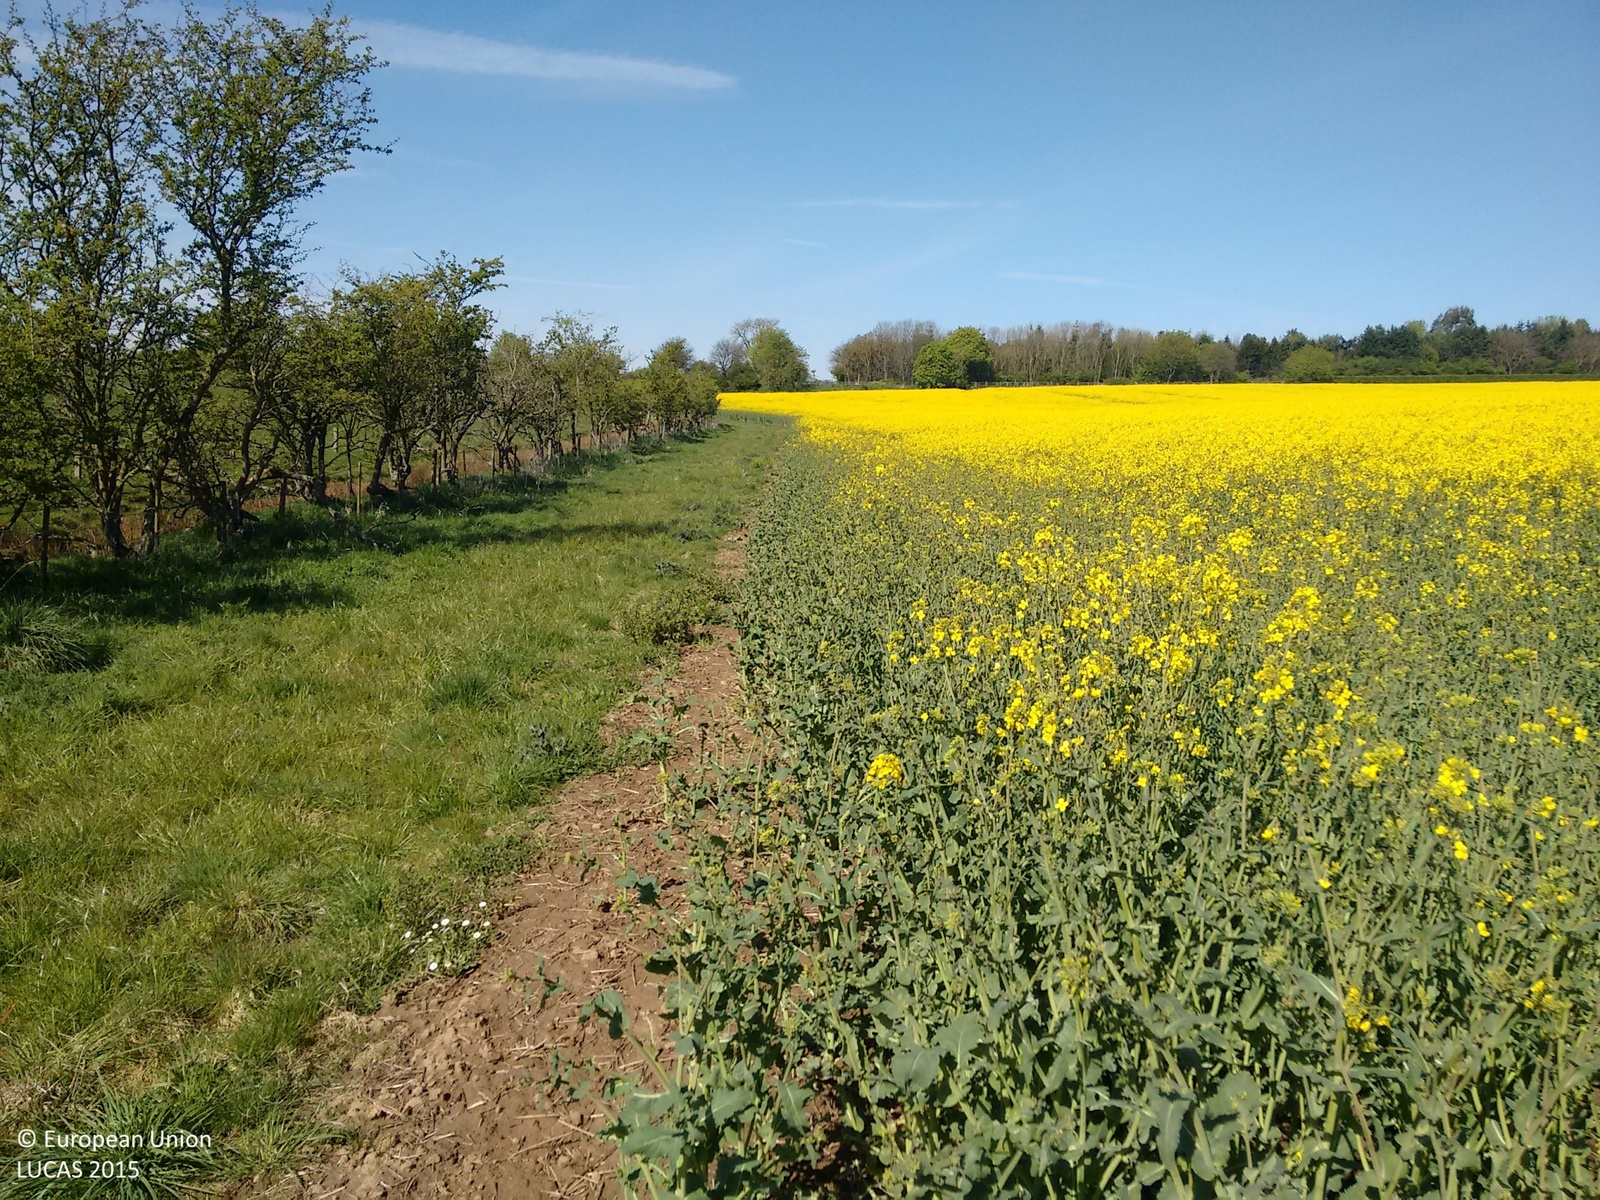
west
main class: Cropland
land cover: Rape and turnip rape
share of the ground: > 75 %
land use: Agriculture (excluding fallow land and kitchen gardens)
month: May
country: GB
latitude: 55.2320
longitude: -1.7009
